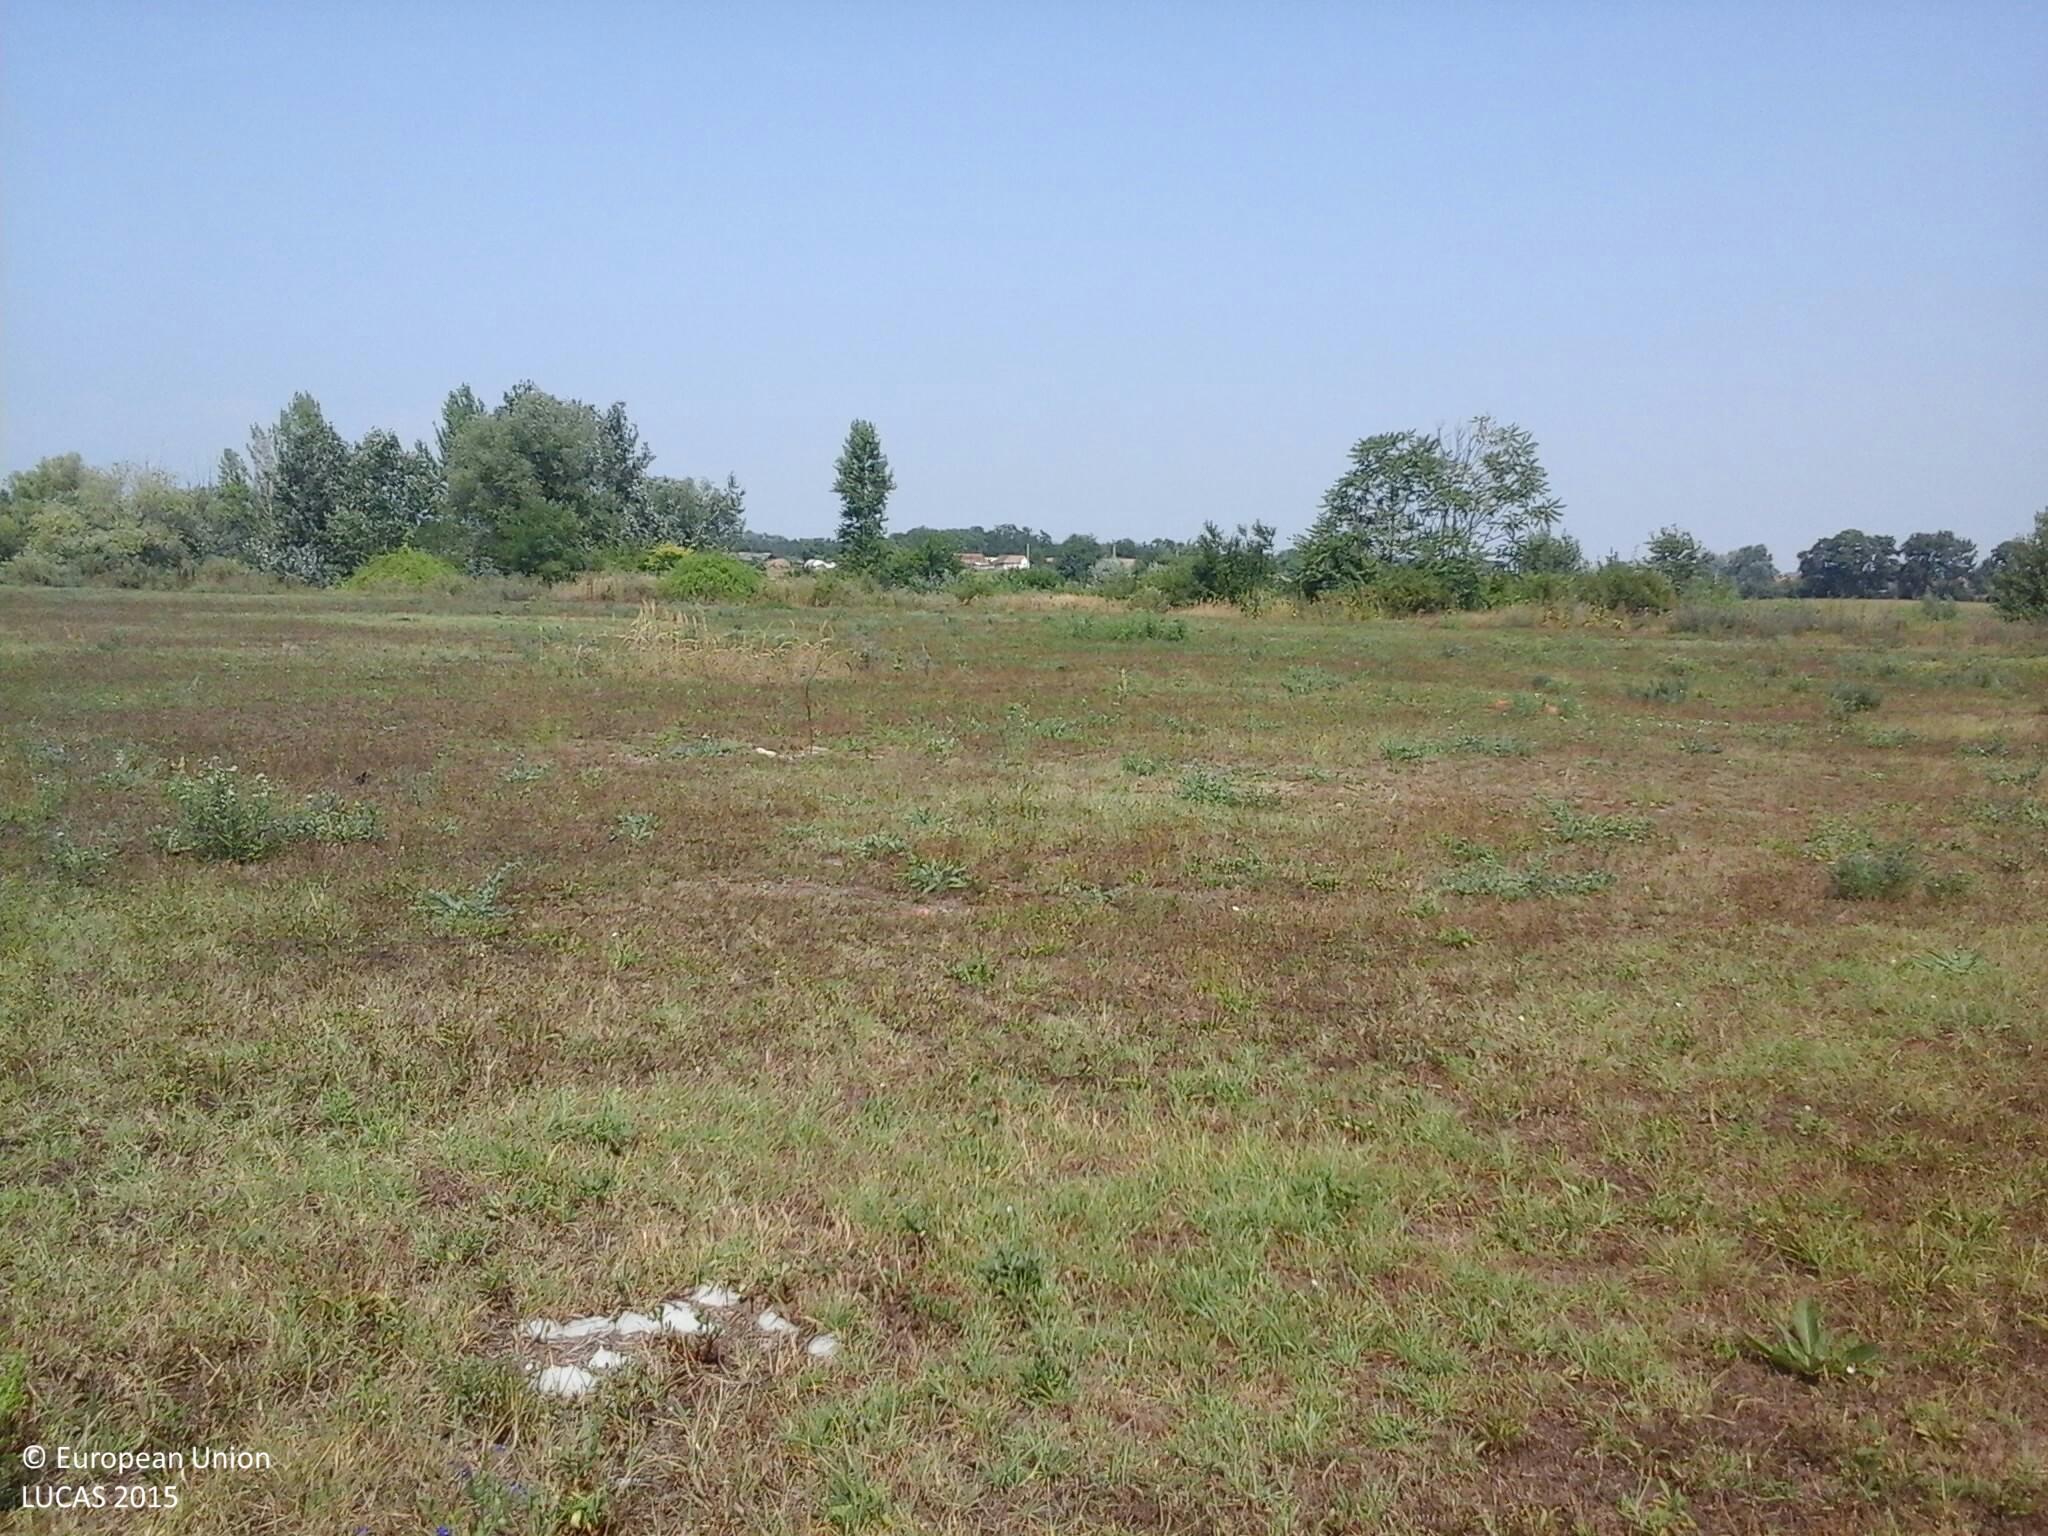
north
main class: Grassland
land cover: Spontaneously vegetated surfaces
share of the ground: > 75 %
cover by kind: herbaceous plants 100 %
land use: Semi-natural and natural areas not in use
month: August
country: HU
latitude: 47.3676
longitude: 19.1952
